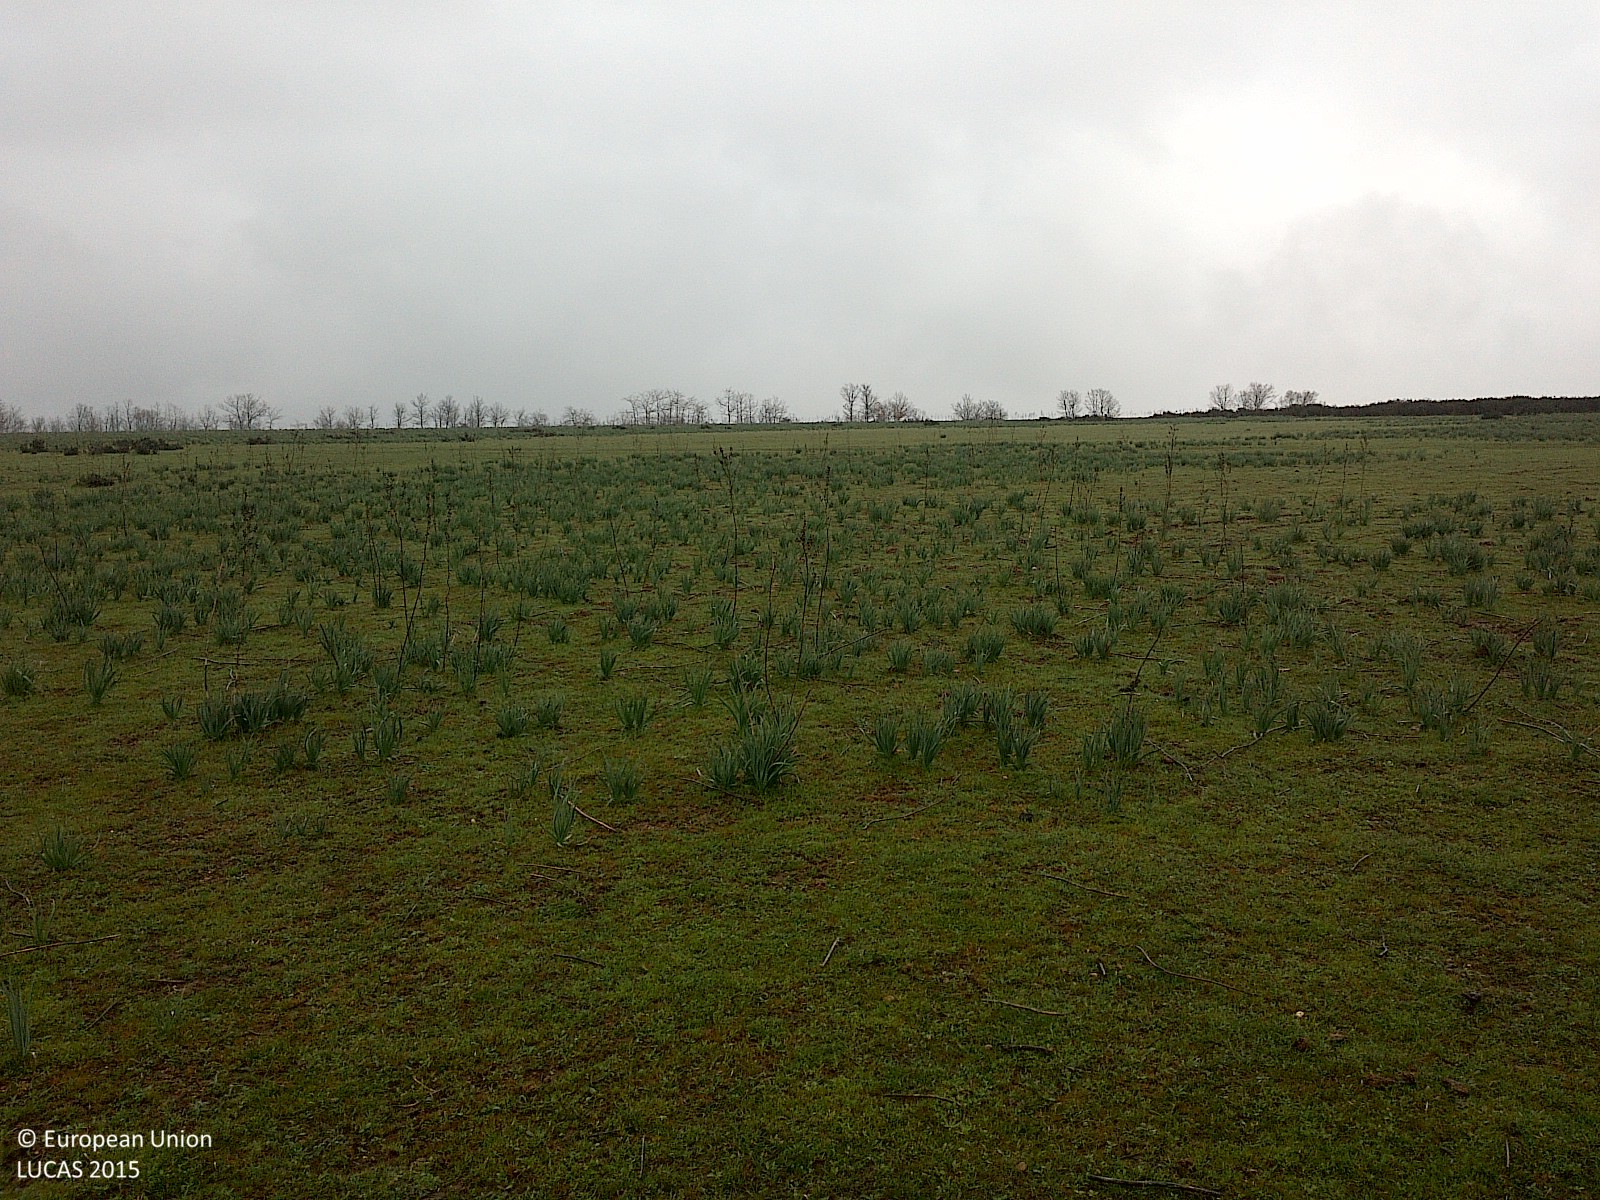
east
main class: Grassland
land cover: Grassland without tree/shrub cover
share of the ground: > 75 %
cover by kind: herbaceous plants 100 %
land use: Agriculture (excluding fallow land and kitchen gardens)
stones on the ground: < 10 %
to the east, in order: Grassland without tree/shrub cover; Grassland with sparse tree/shrub cover
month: April
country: ES
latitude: 42.0284
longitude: -3.3010
